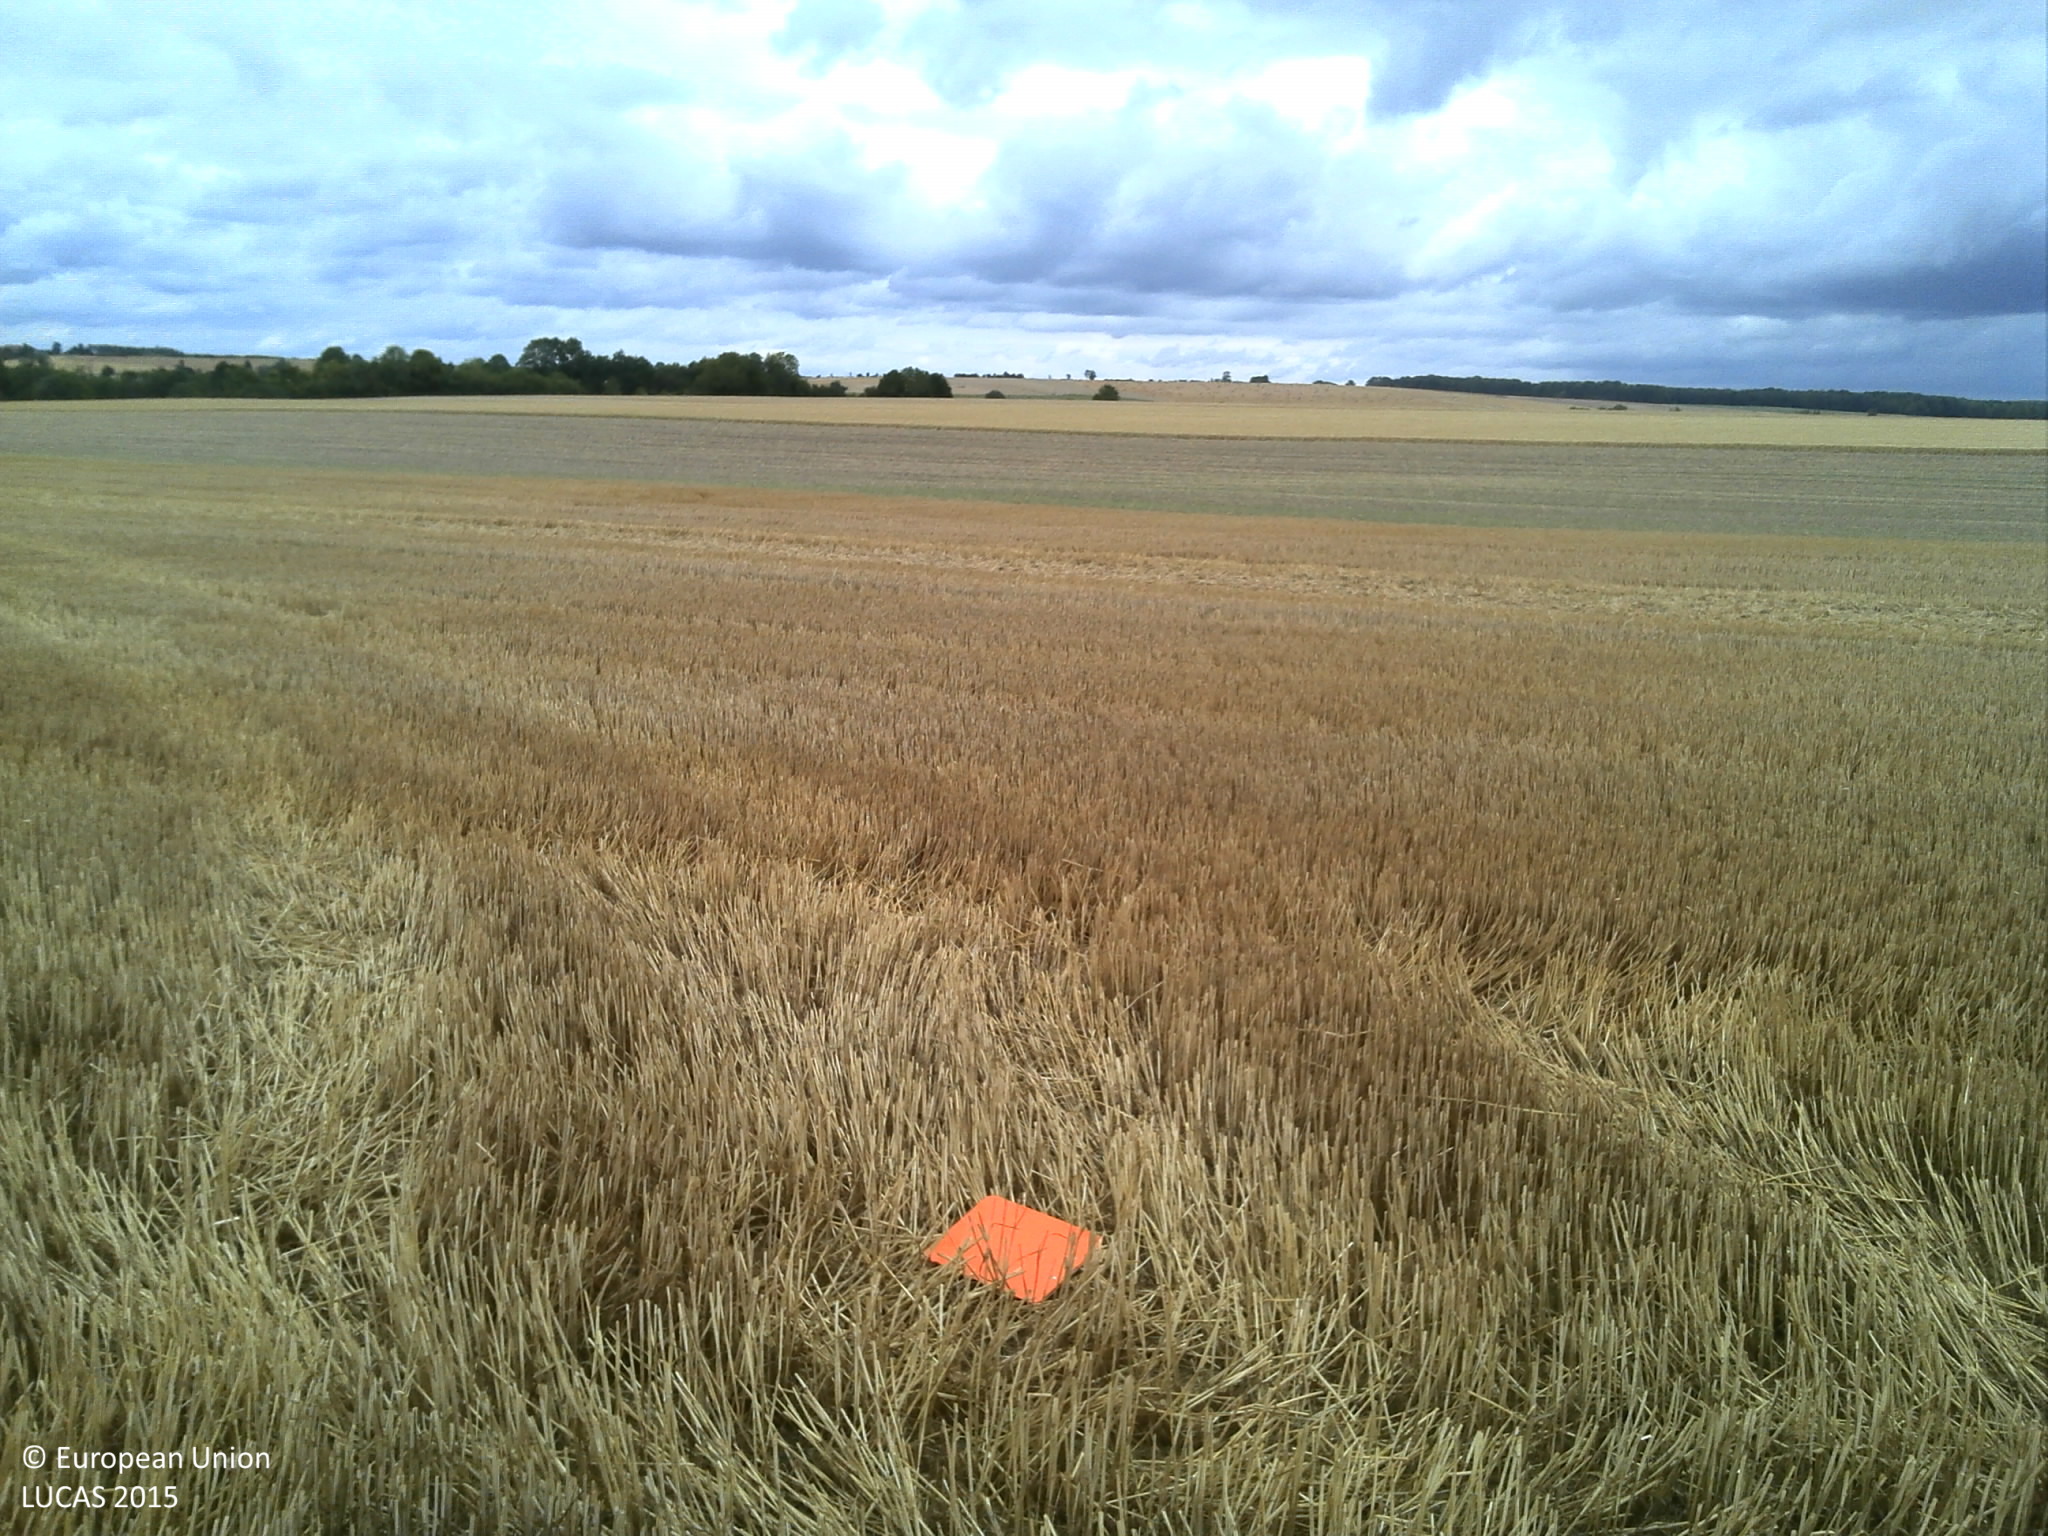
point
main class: Cropland
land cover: Common wheat
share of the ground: 50 - 75 %
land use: Agriculture (excluding fallow land and kitchen gardens)
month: July
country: FR
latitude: 49.4809
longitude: 4.6274
